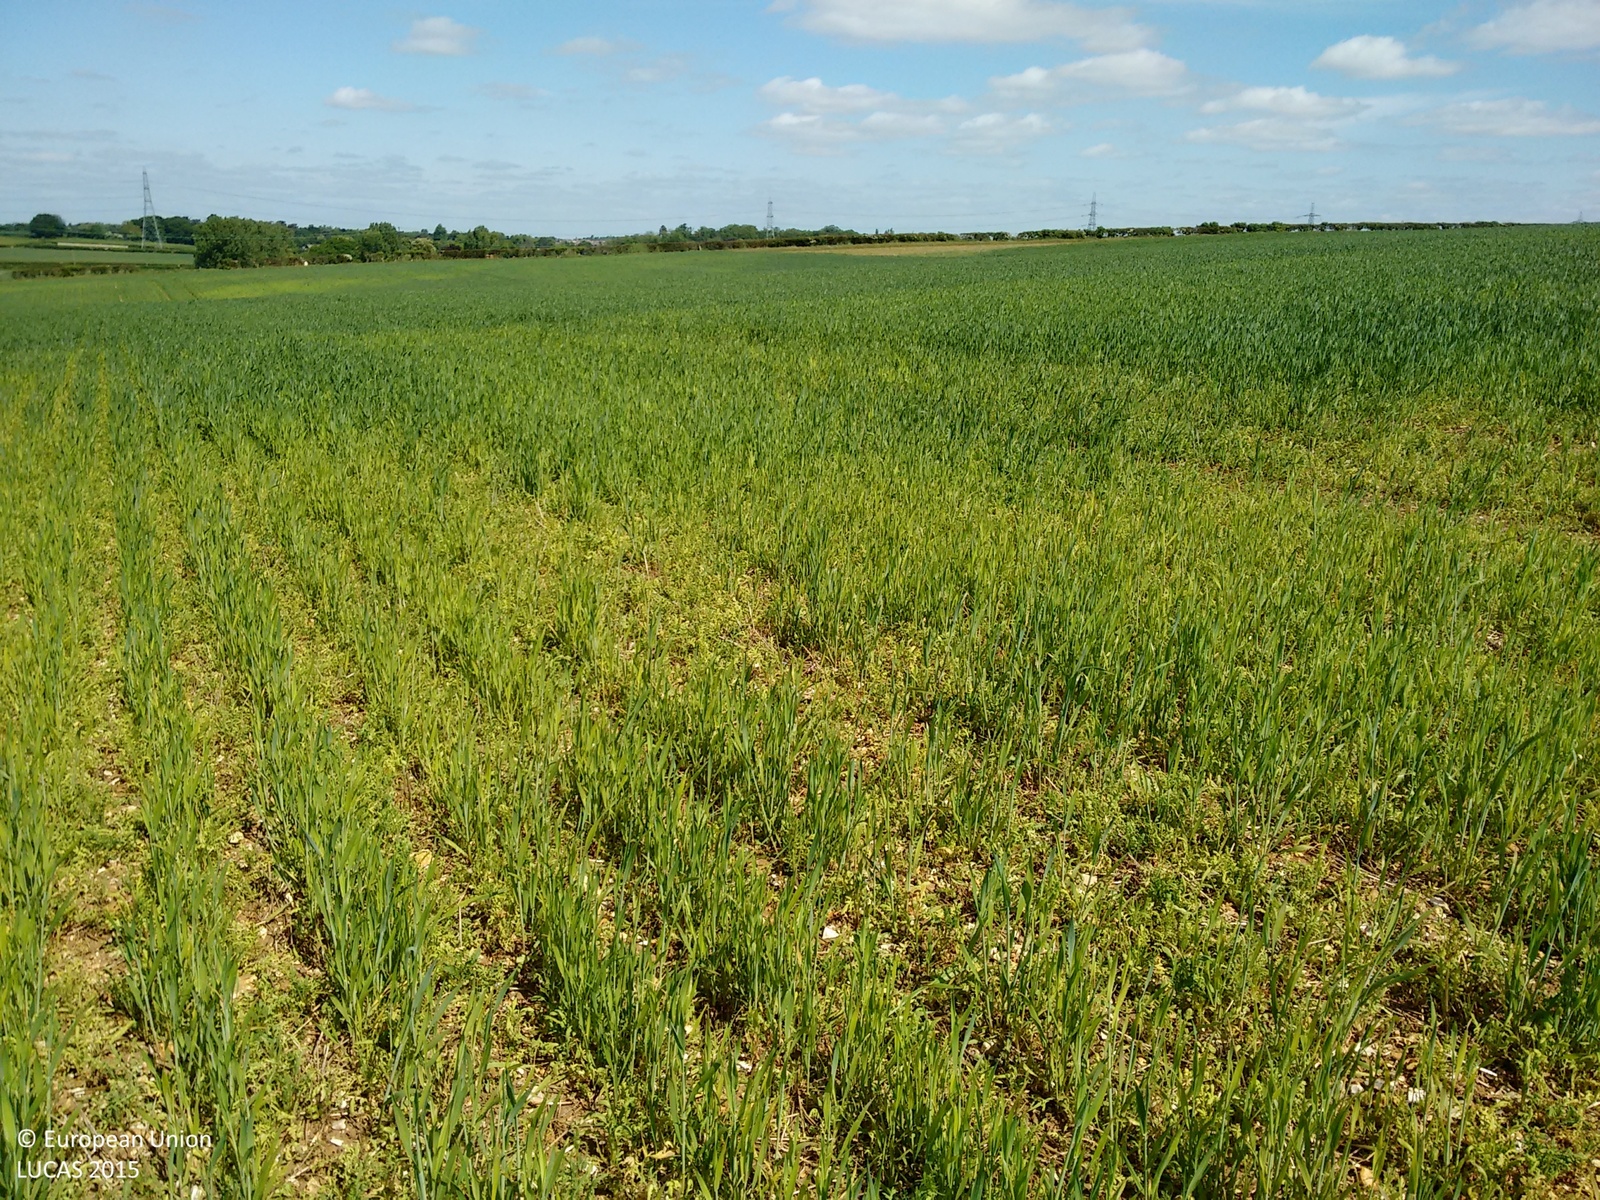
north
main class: Cropland
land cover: Common wheat
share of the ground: > 75 %
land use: Agriculture (excluding fallow land and kitchen gardens)
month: May
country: GB
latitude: 51.9140
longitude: -0.2557
